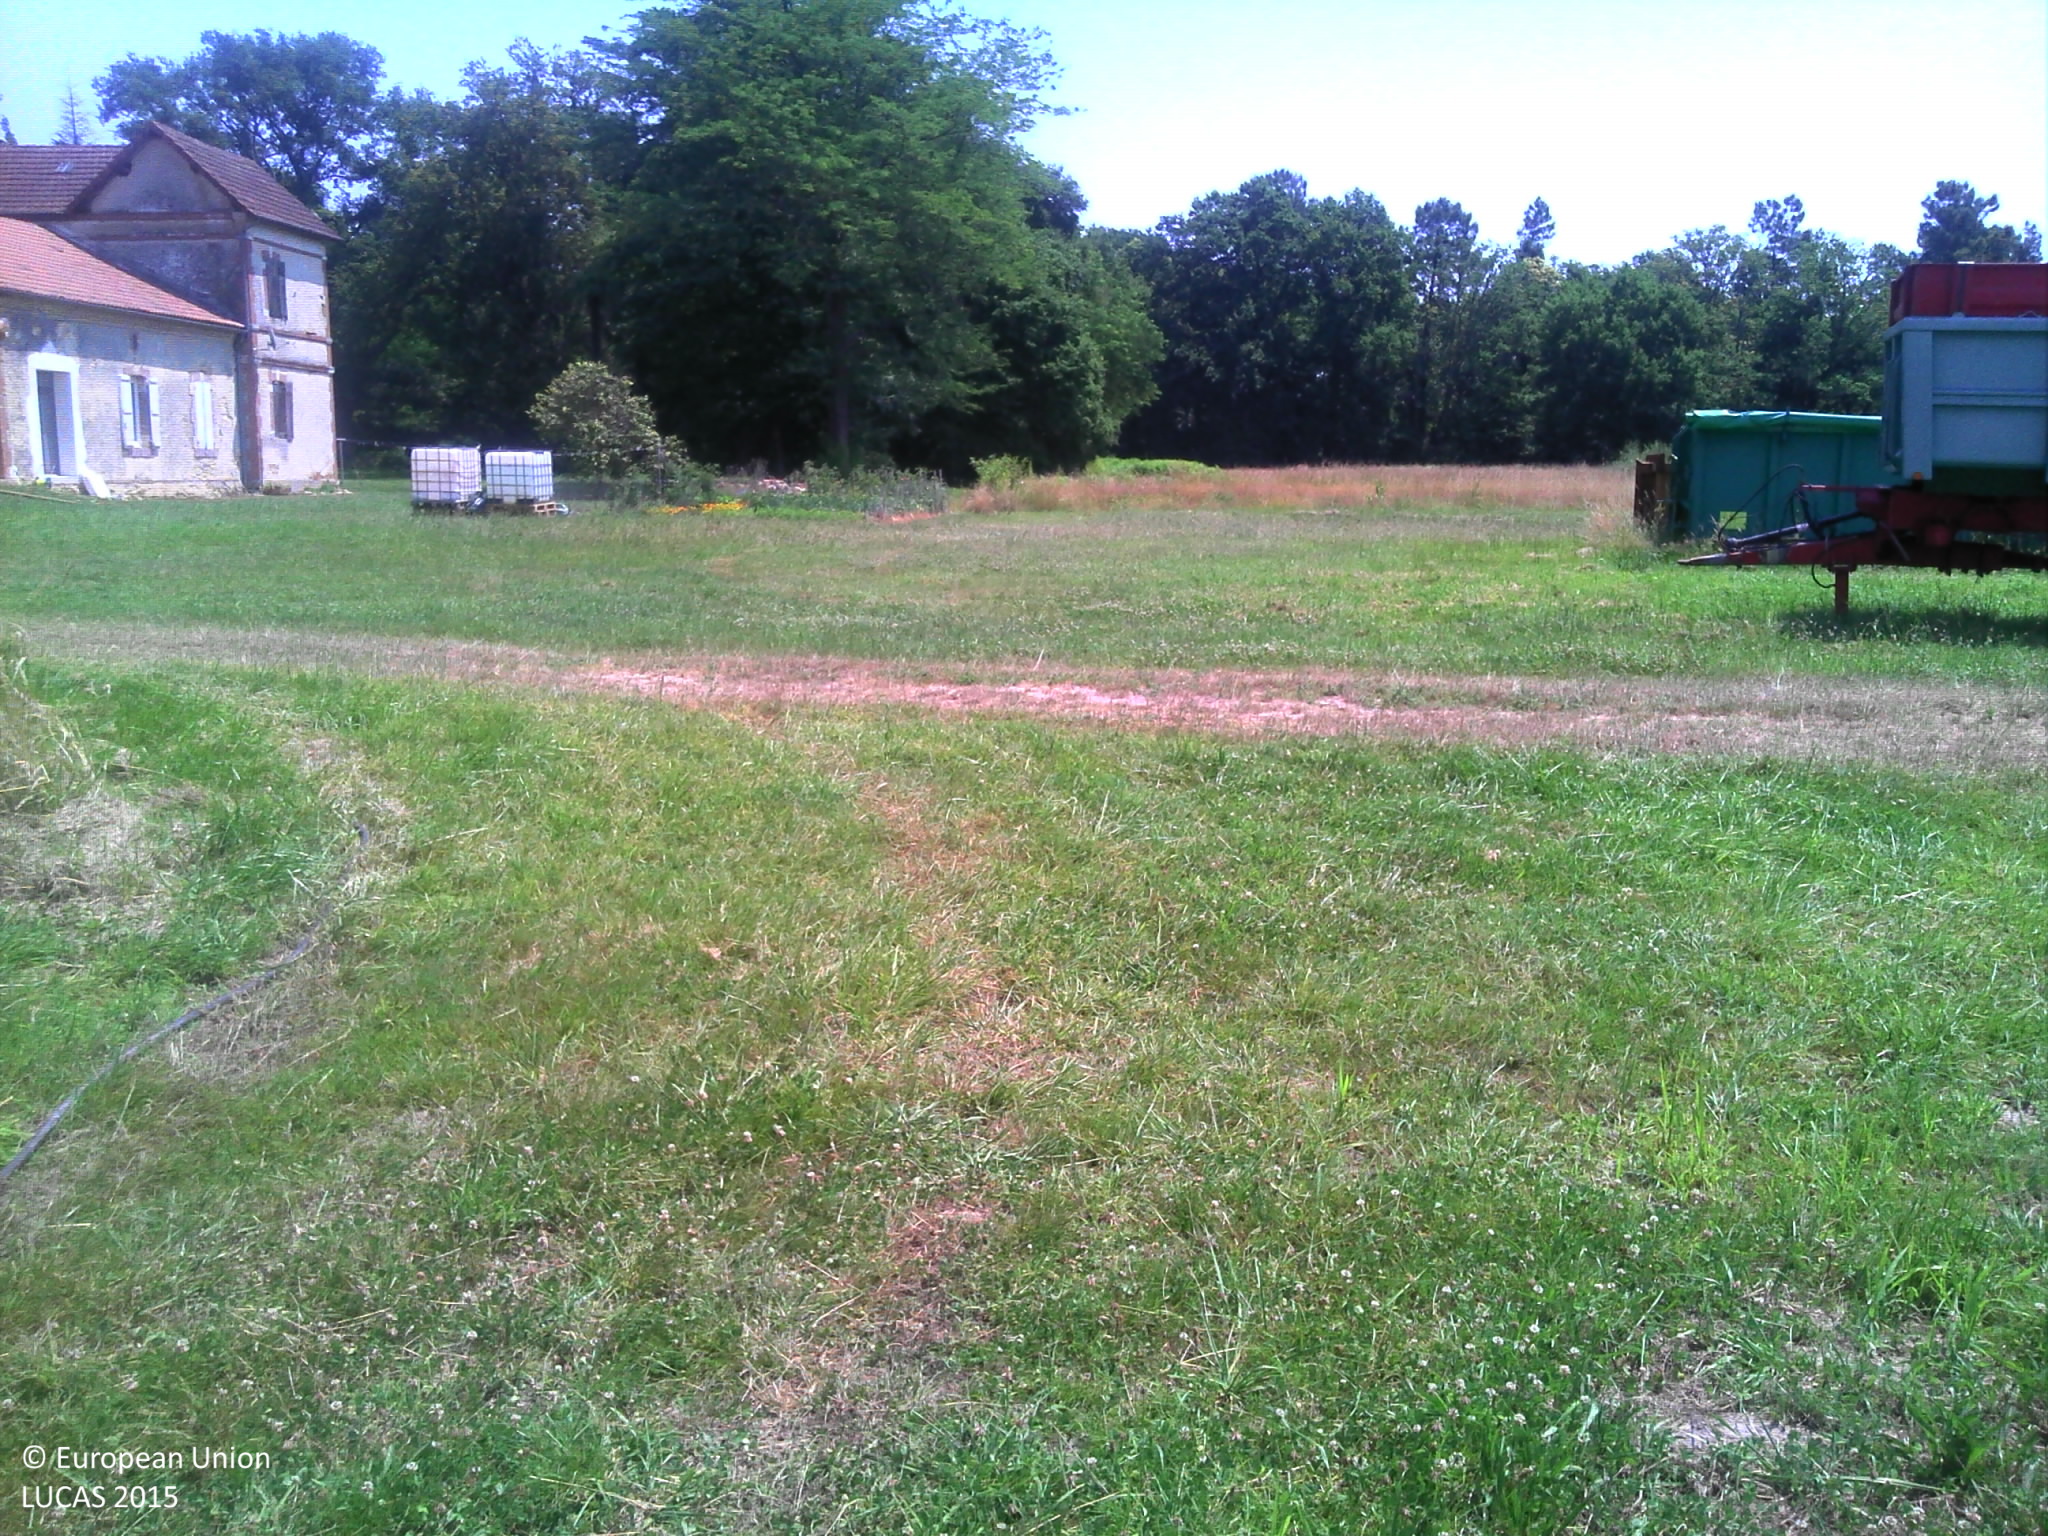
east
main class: Grassland
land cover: Grassland with sparse tree/shrub cover
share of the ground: > 75 %
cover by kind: herbaceous plants 95 %, broadleaved forest trees 5 %
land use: Agriculture (excluding fallow land and kitchen gardens)
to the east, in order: Grassland with sparse tree/shrub cover; Tracks; Grassland with sparse tree/shrub cover; Artificial constructions in urban areas; Single bushes/trees; Grassland with sparse tree/shrub cover; Broadleaved woodland; Fences; Grassland with sparse tree/shrub cover
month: June
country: FR
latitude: 43.9671
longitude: -0.2683
